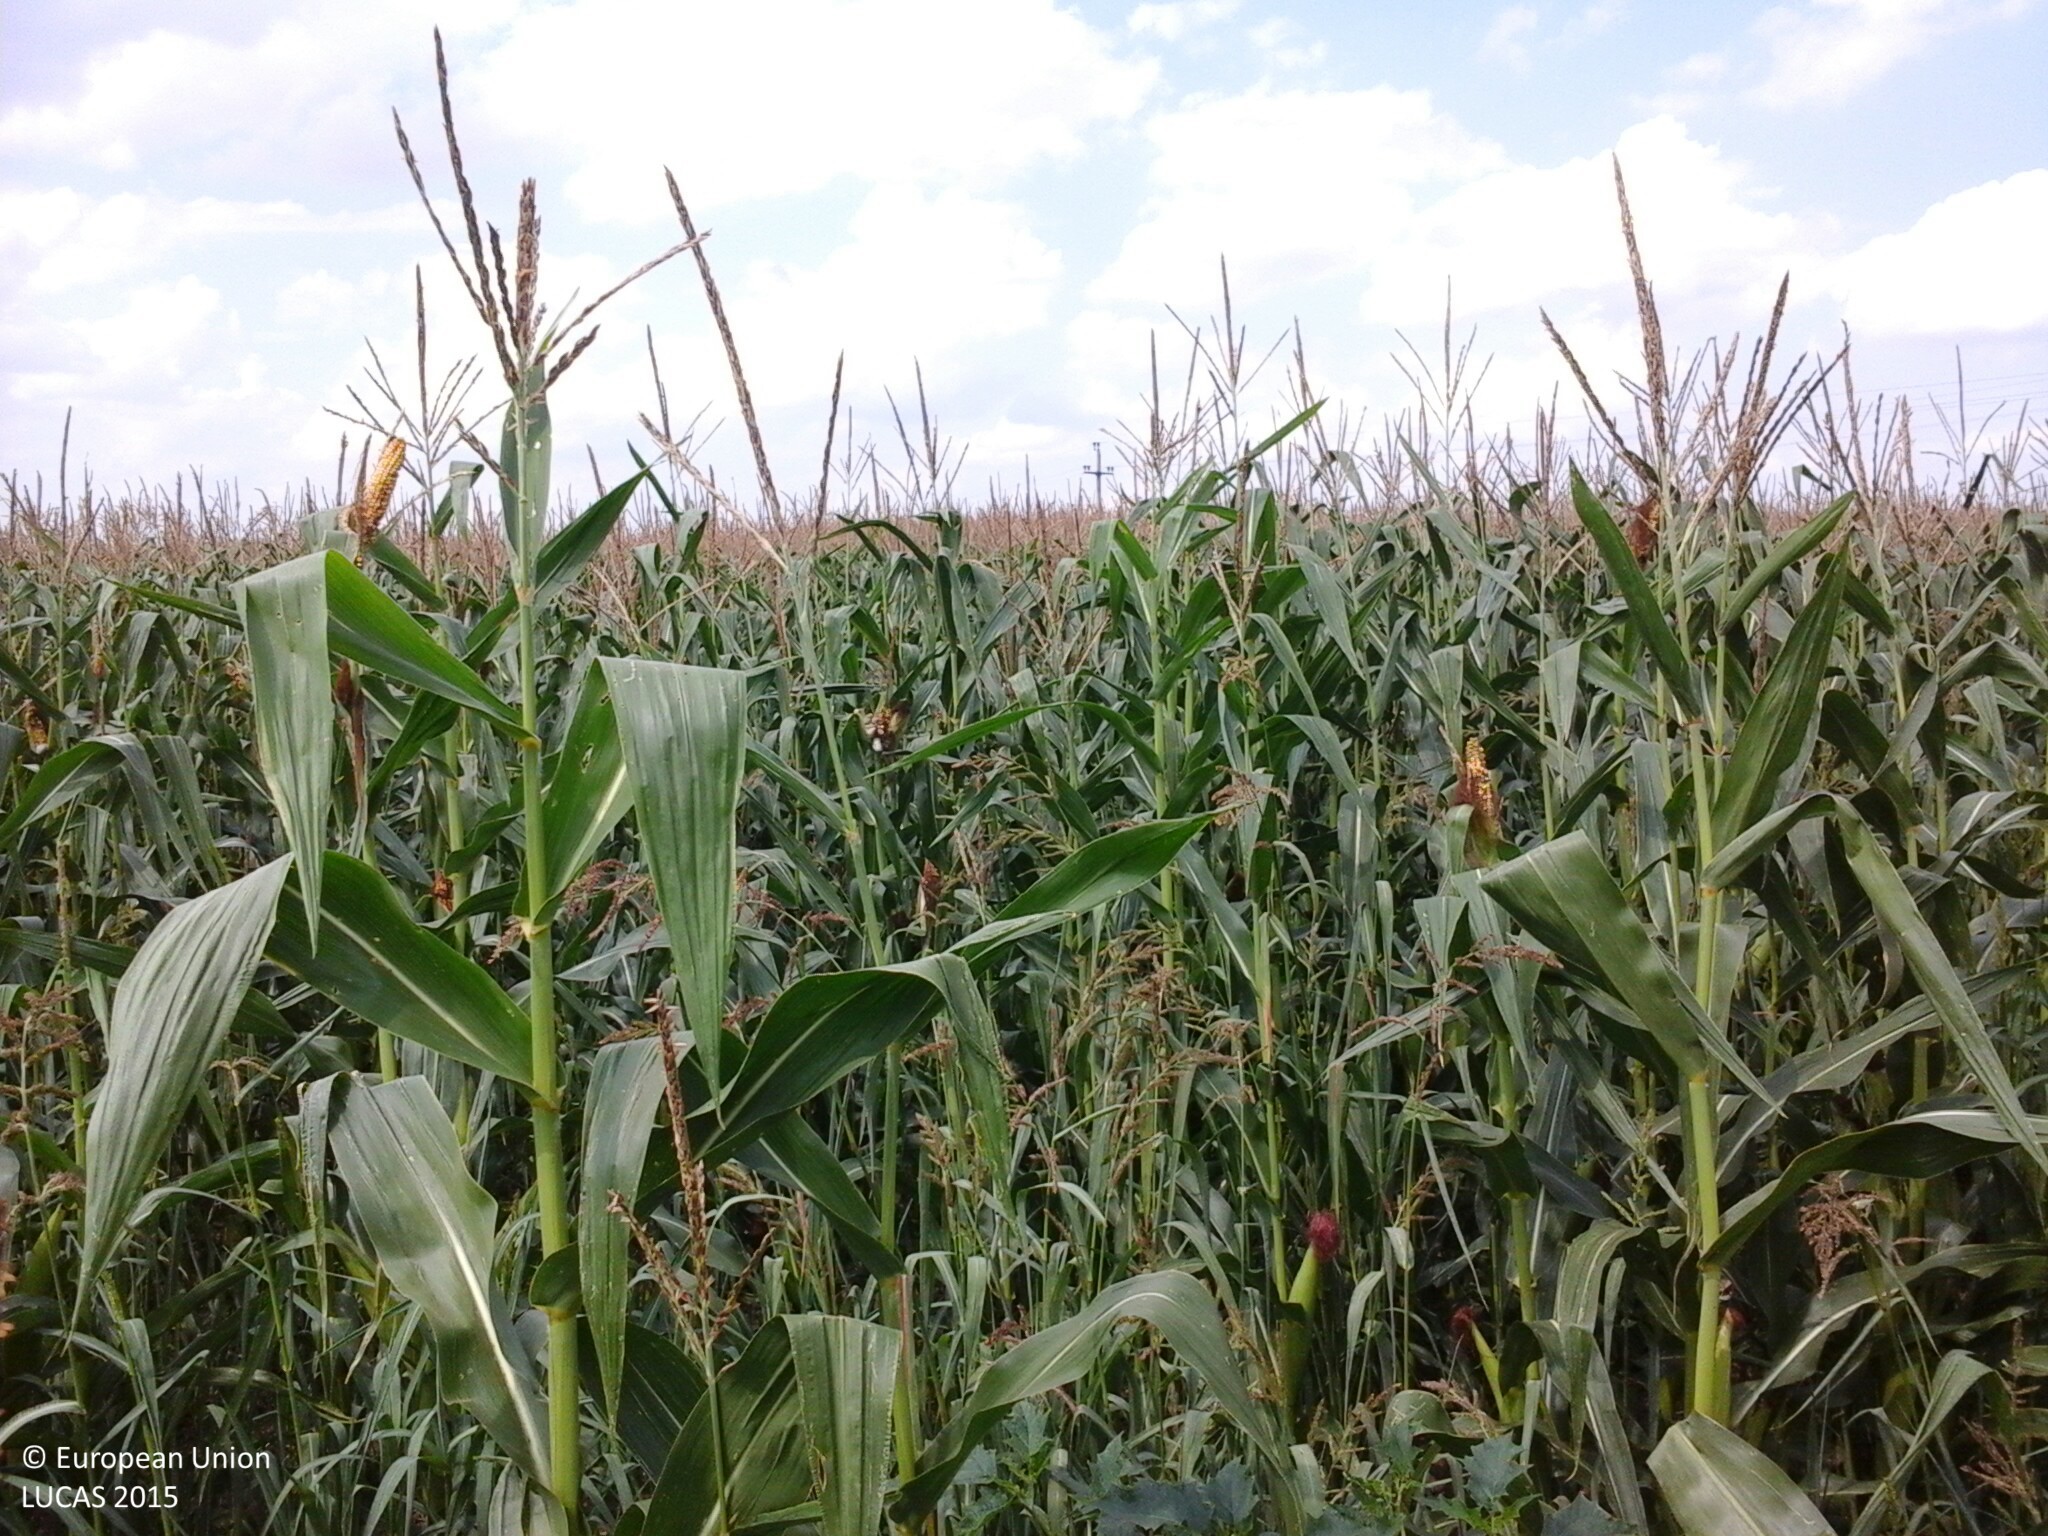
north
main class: Cropland
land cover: Maize
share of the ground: > 75 %
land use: Agriculture (excluding fallow land and kitchen gardens)
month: August
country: HU
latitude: 47.0347
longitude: 18.1560
